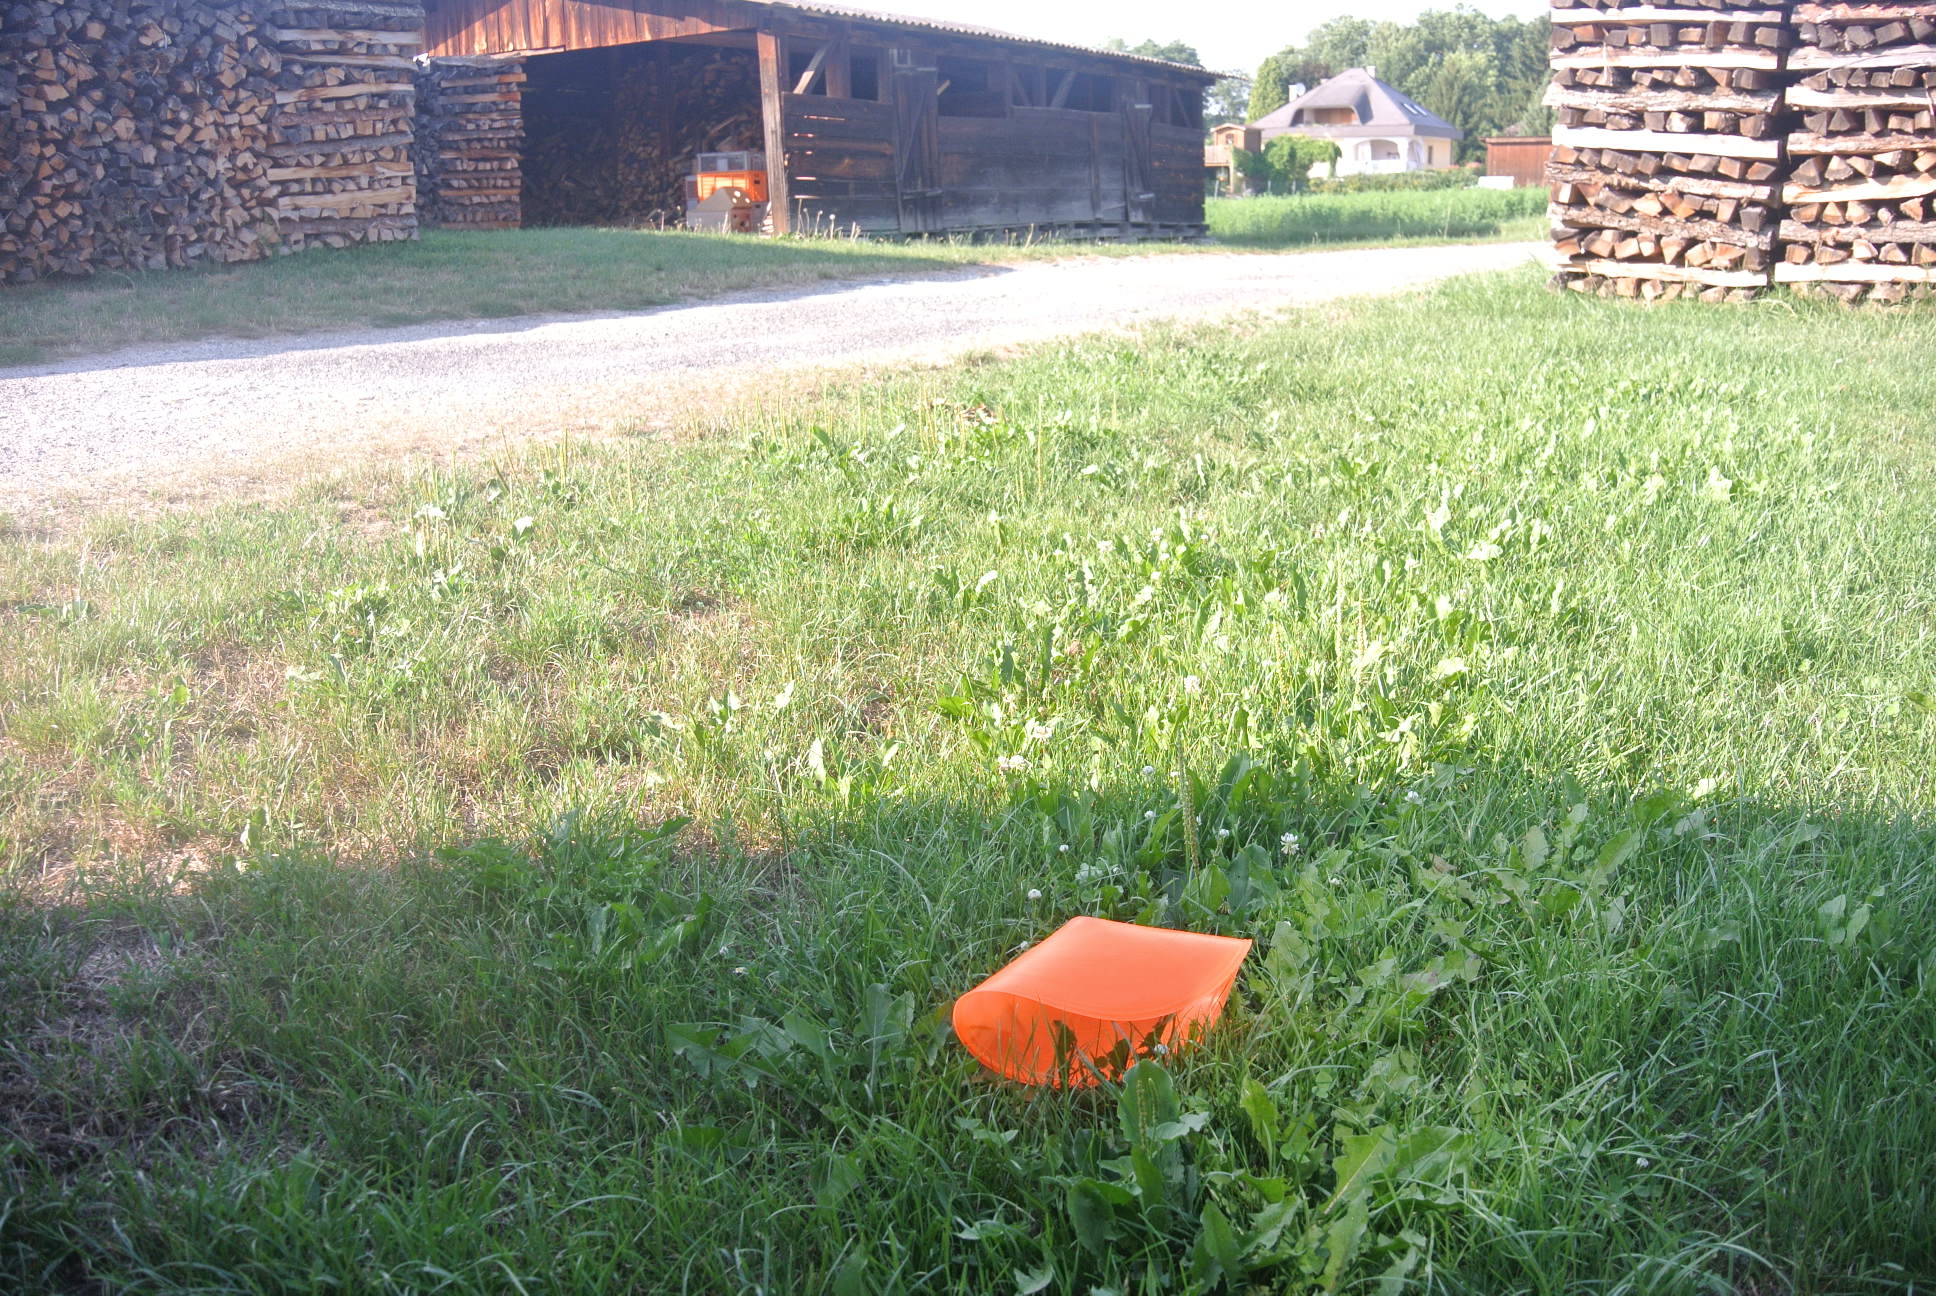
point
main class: Grassland
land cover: Grassland without tree/shrub cover
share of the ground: > 75 %
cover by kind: herbaceous plants 100 %
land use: Residential
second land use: Agriculture (excluding fallow land and kitchen gardens)
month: July
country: AT
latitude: 47.4725
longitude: 16.4919
